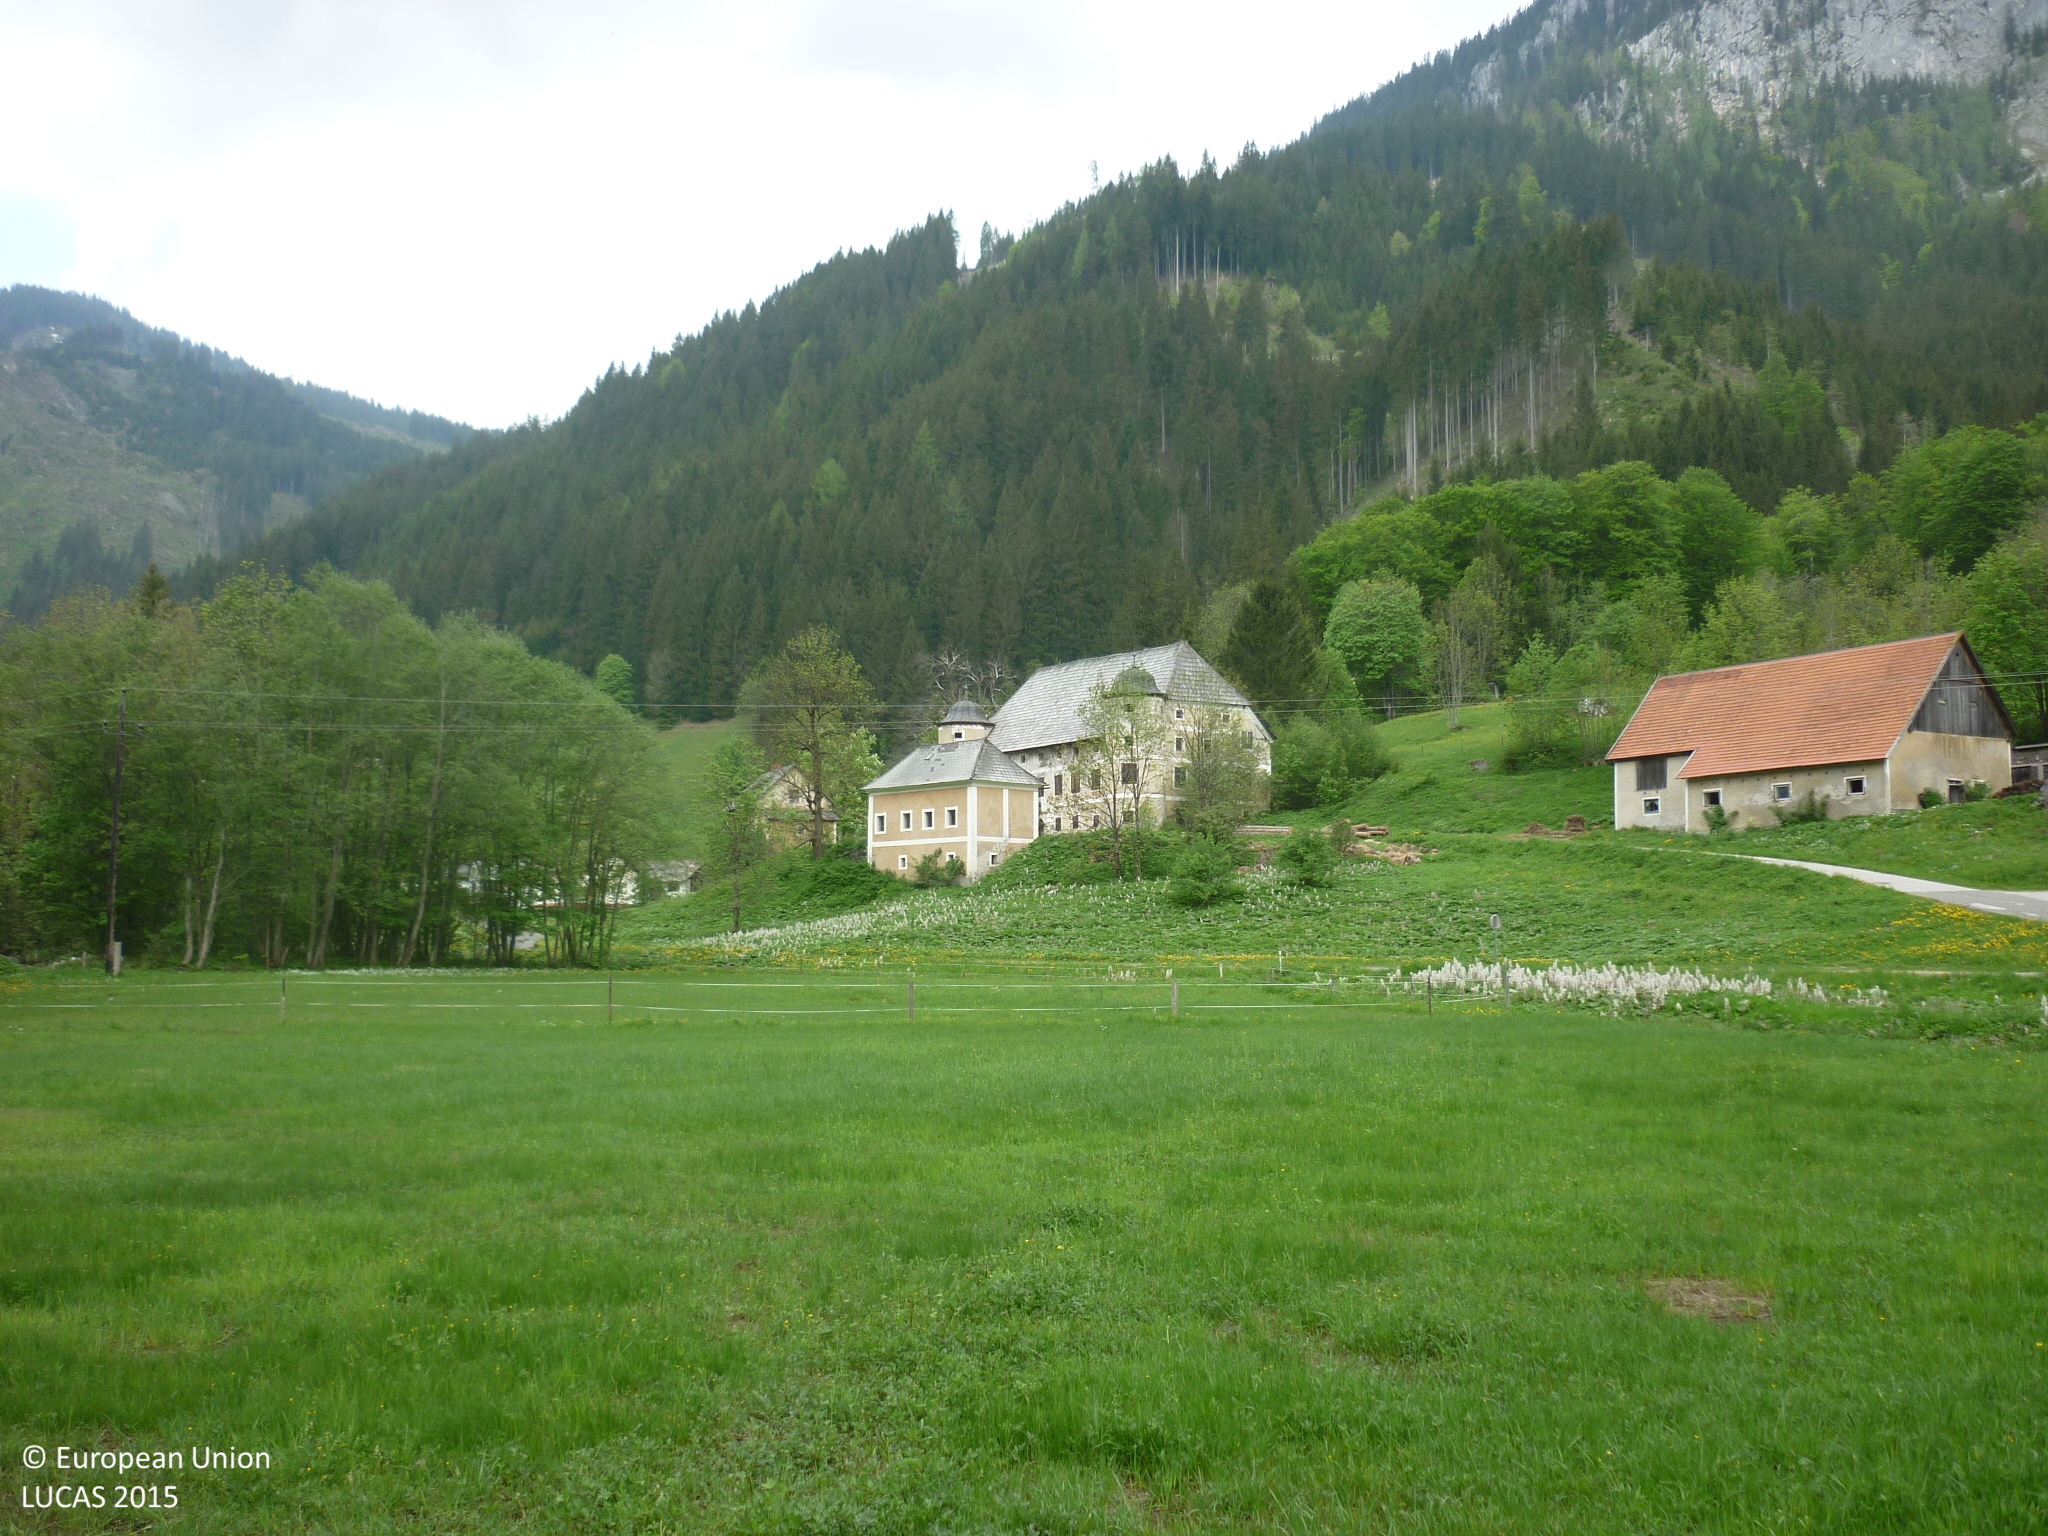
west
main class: Grassland
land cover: Grassland without tree/shrub cover
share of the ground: > 75 %
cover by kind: herbaceous plants 100 %
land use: Agriculture (excluding fallow land and kitchen gardens)
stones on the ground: < 10 %
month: May
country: AT
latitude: 47.5278
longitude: 14.7147
